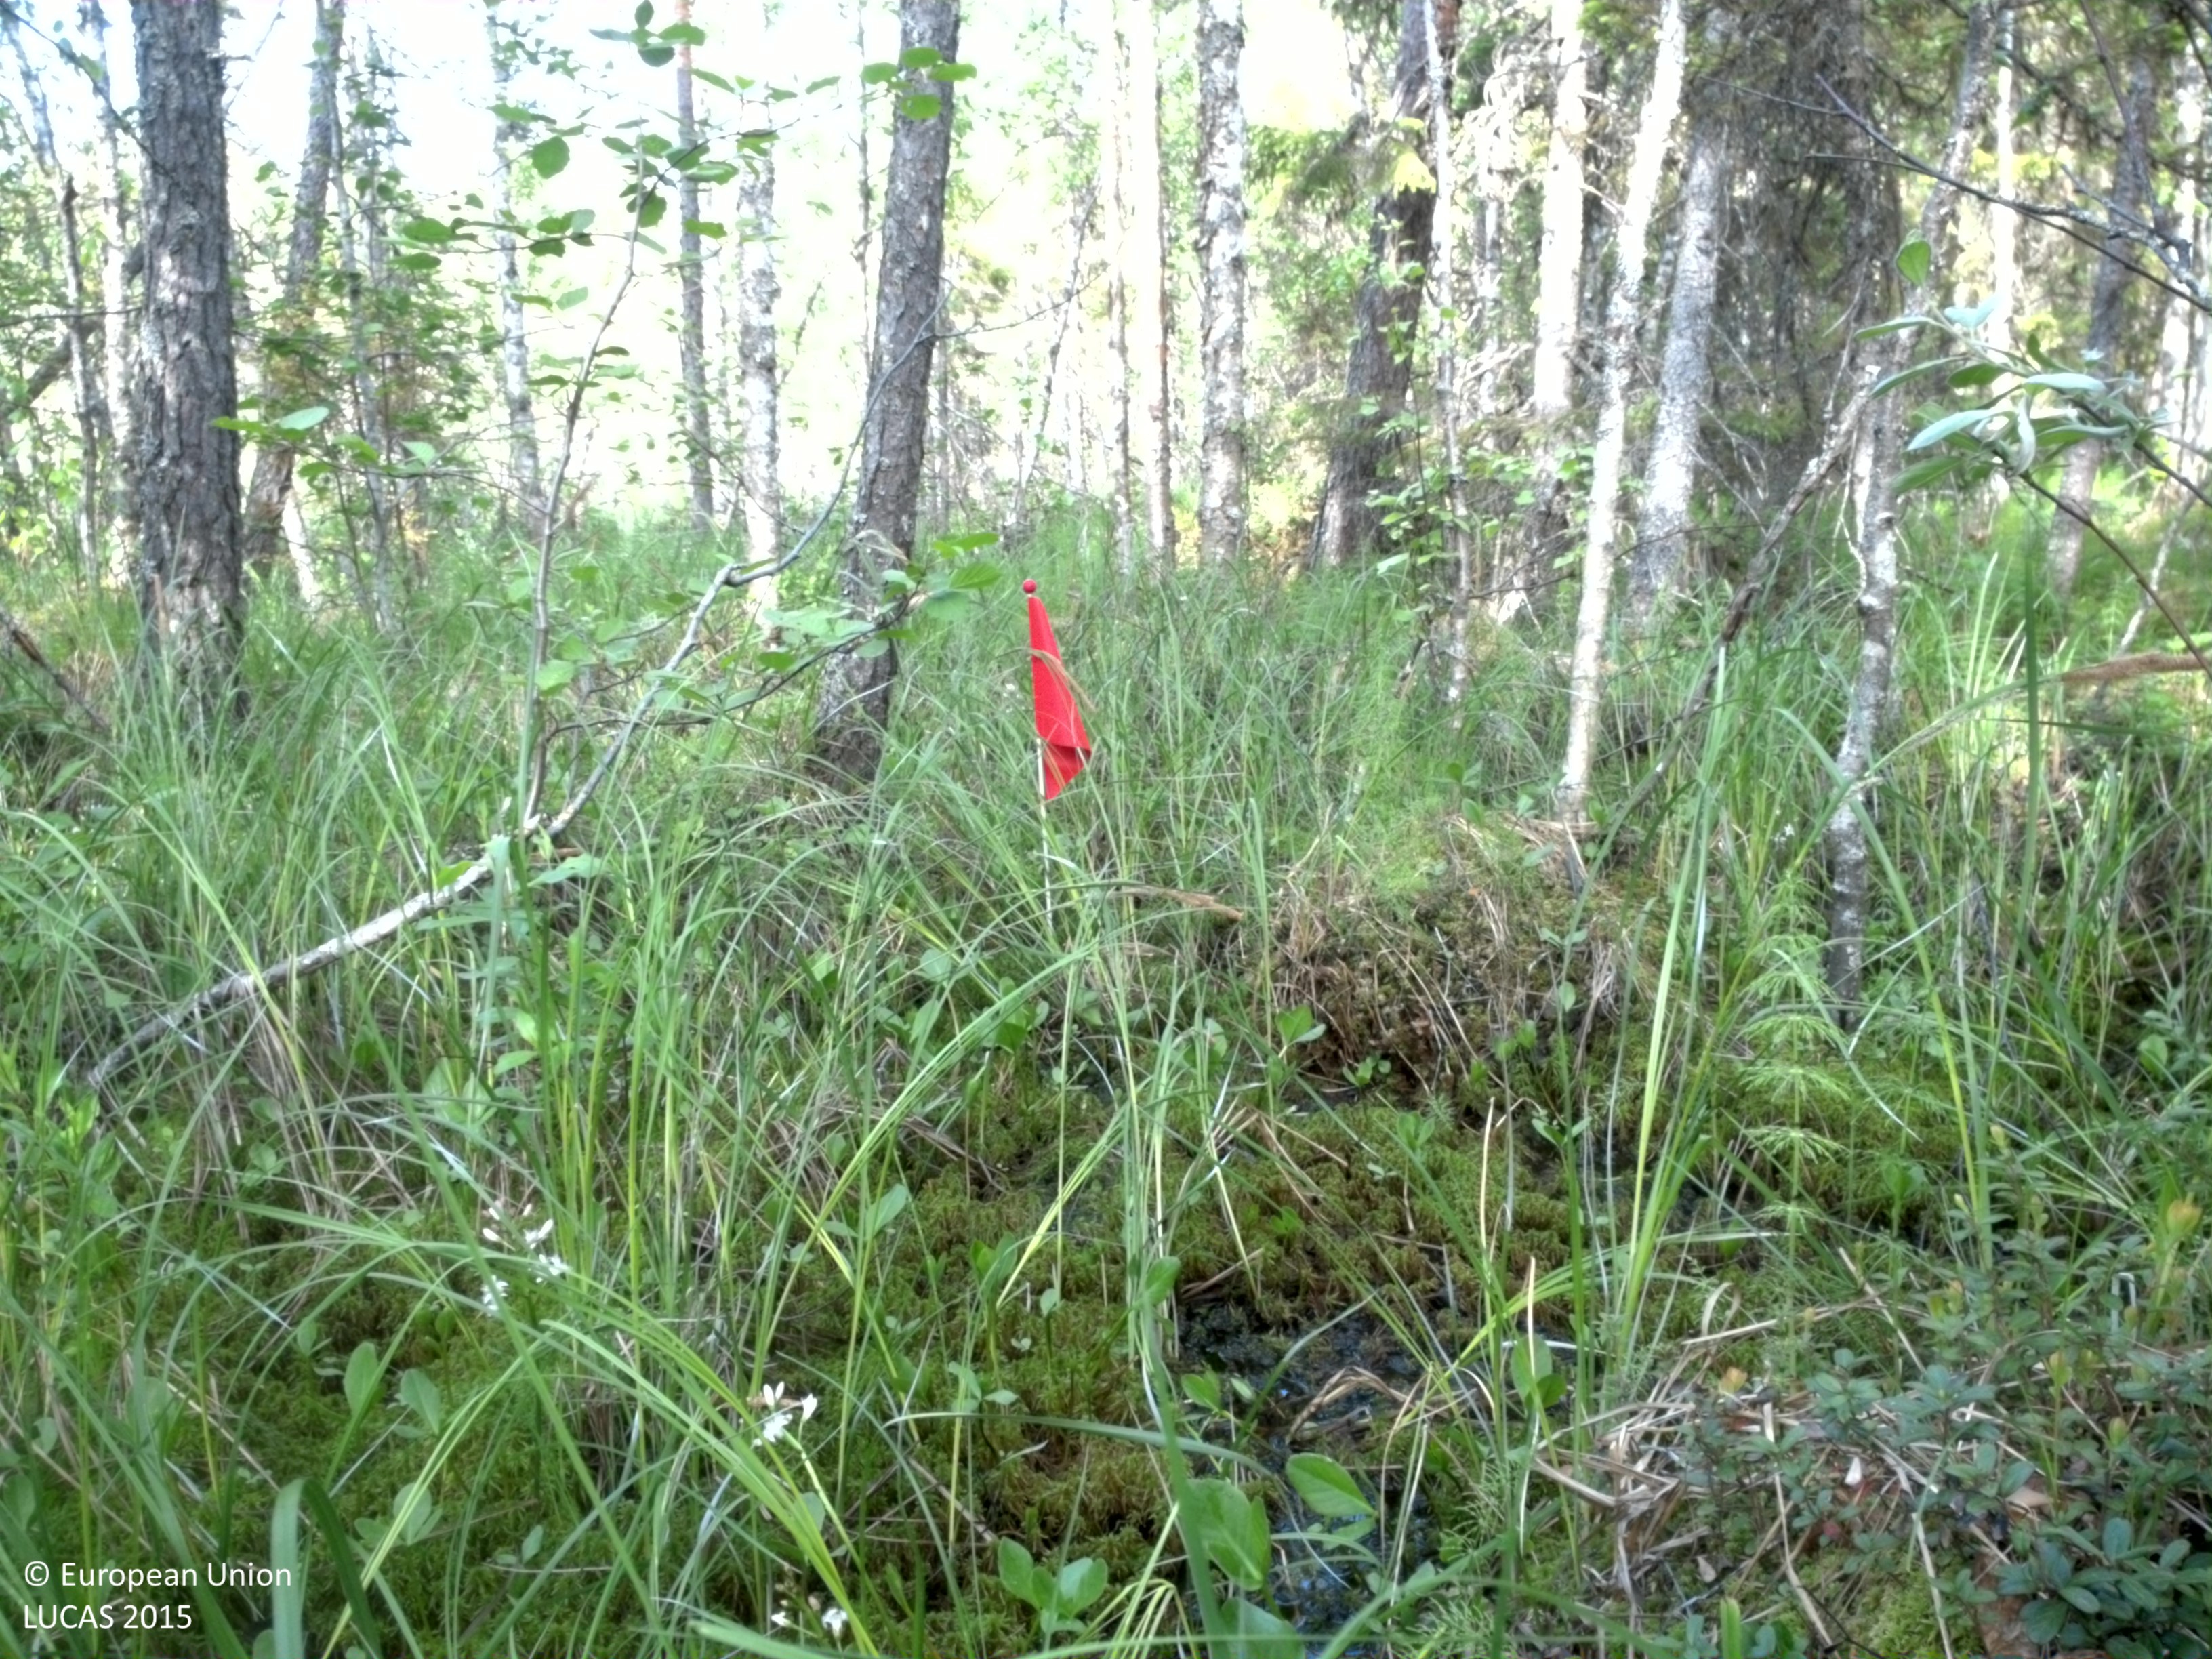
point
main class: Woodland
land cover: Pine dominated mixed woodland
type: mire and swamp forests
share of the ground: 50 - 75 %
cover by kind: broadleaved forest trees 30 %, coniferous forest trees 25 %, herbaceous plants 20 %, lichens and mosses 10 %, shrubs 5 %
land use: Semi-natural and natural areas not in use
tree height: > 5 m
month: June
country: SE
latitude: 66.2488
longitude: 22.7719
